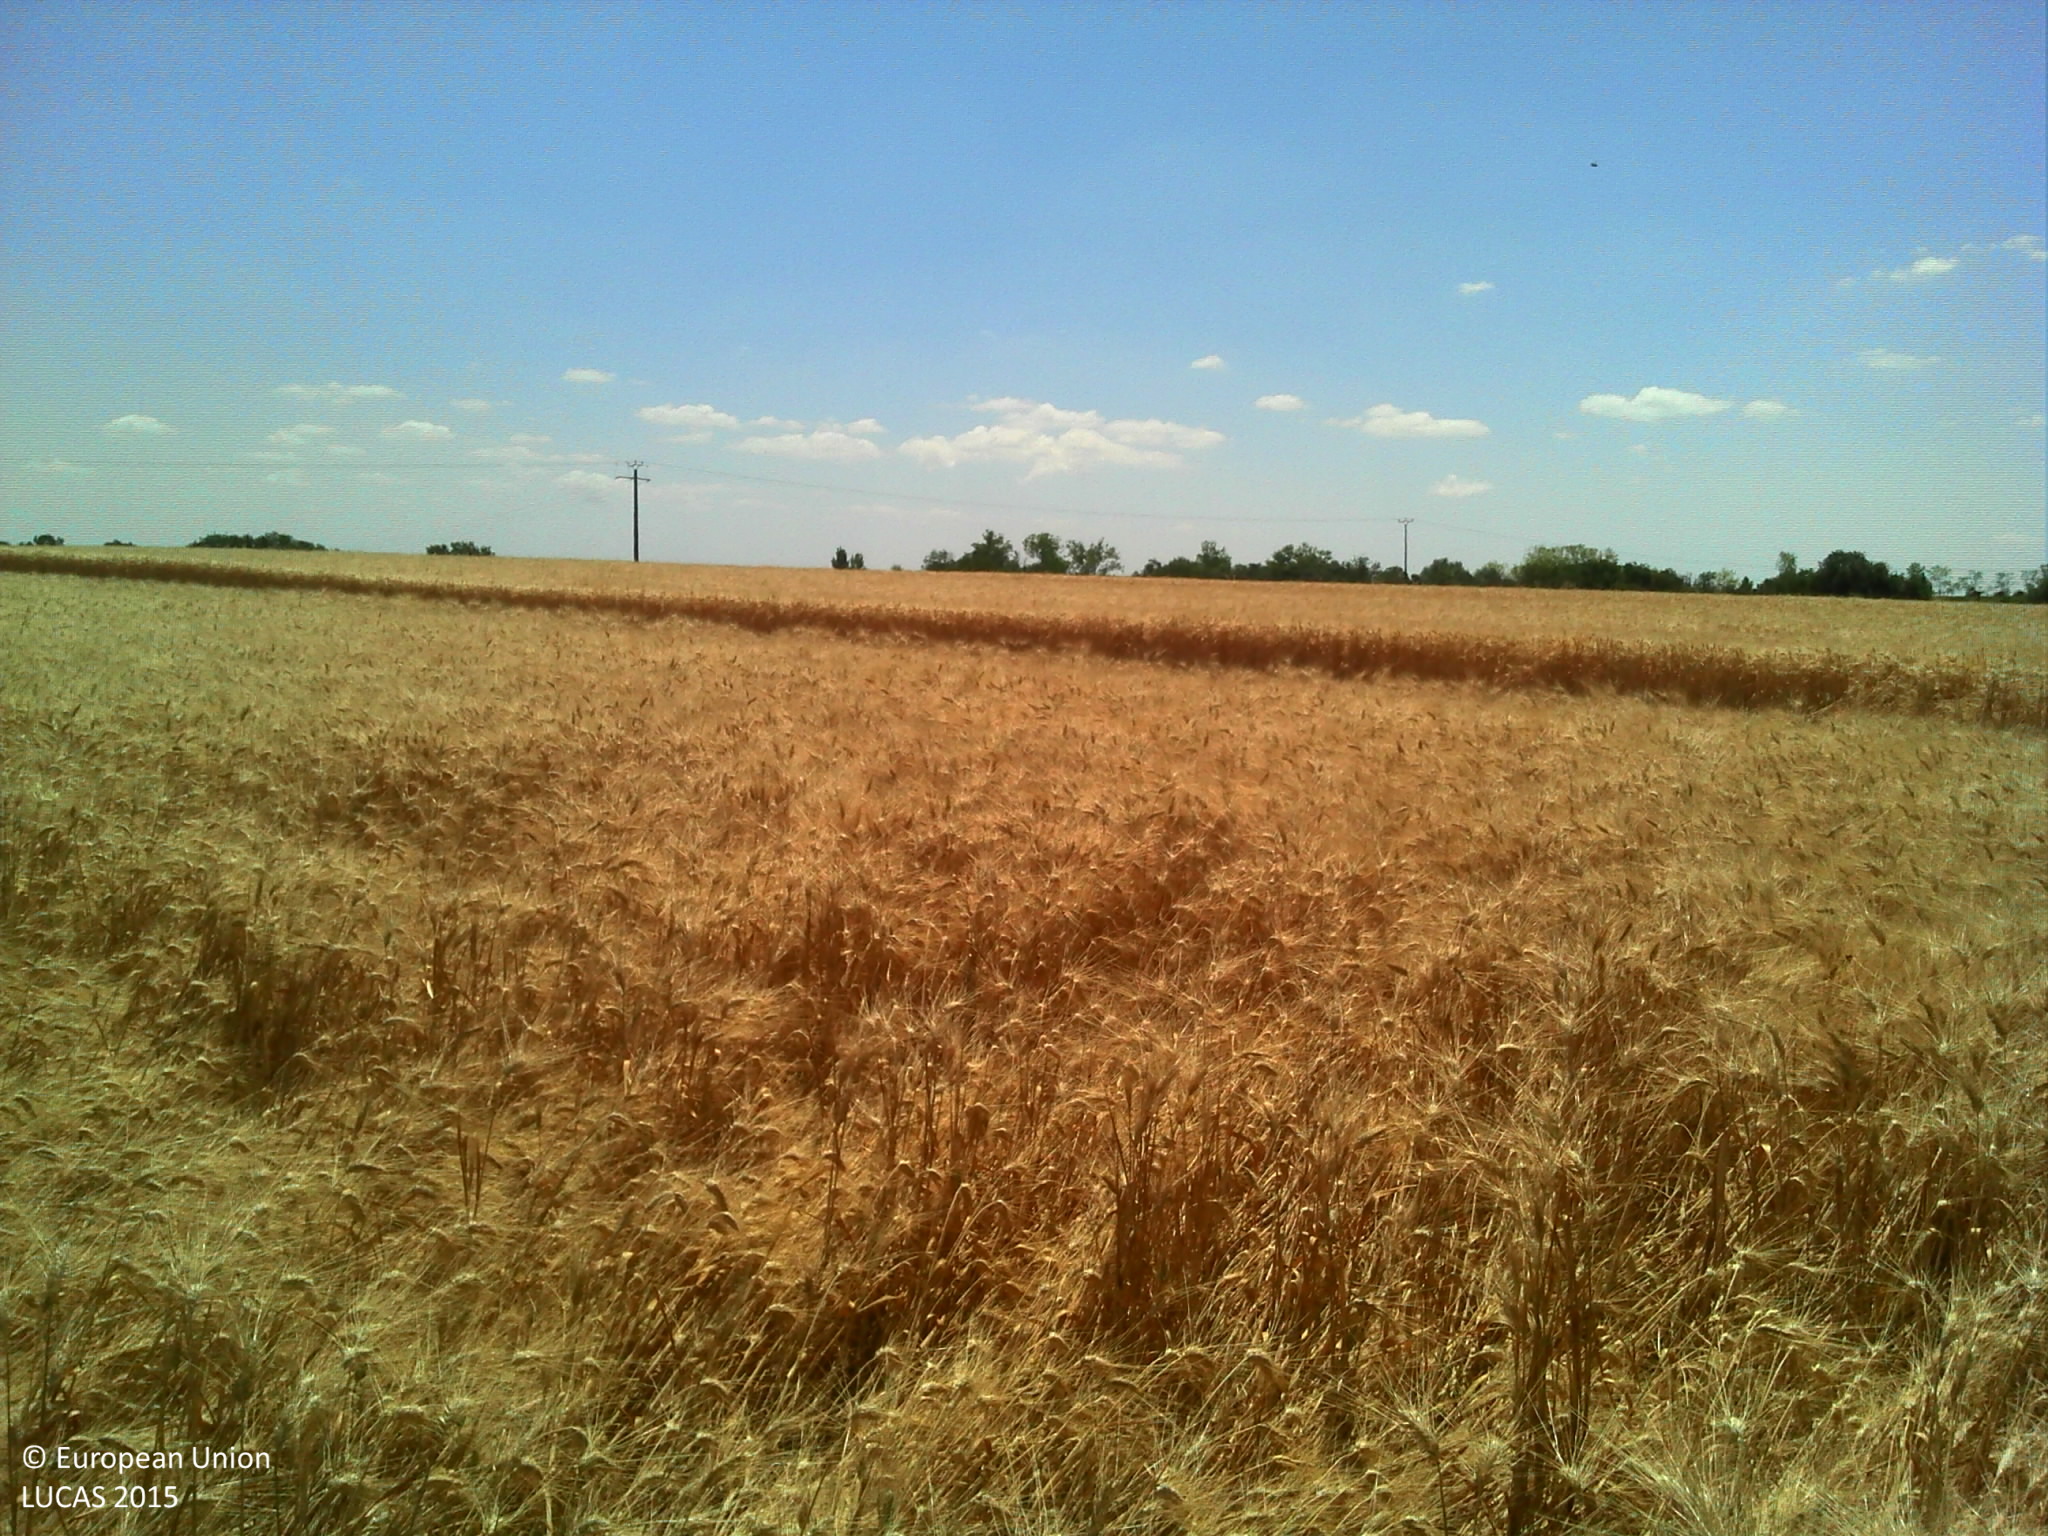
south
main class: Cropland
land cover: Common wheat
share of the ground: > 75 %
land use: Agriculture (excluding fallow land and kitchen gardens)
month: July
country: FR
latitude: 46.4595
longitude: -1.2979
